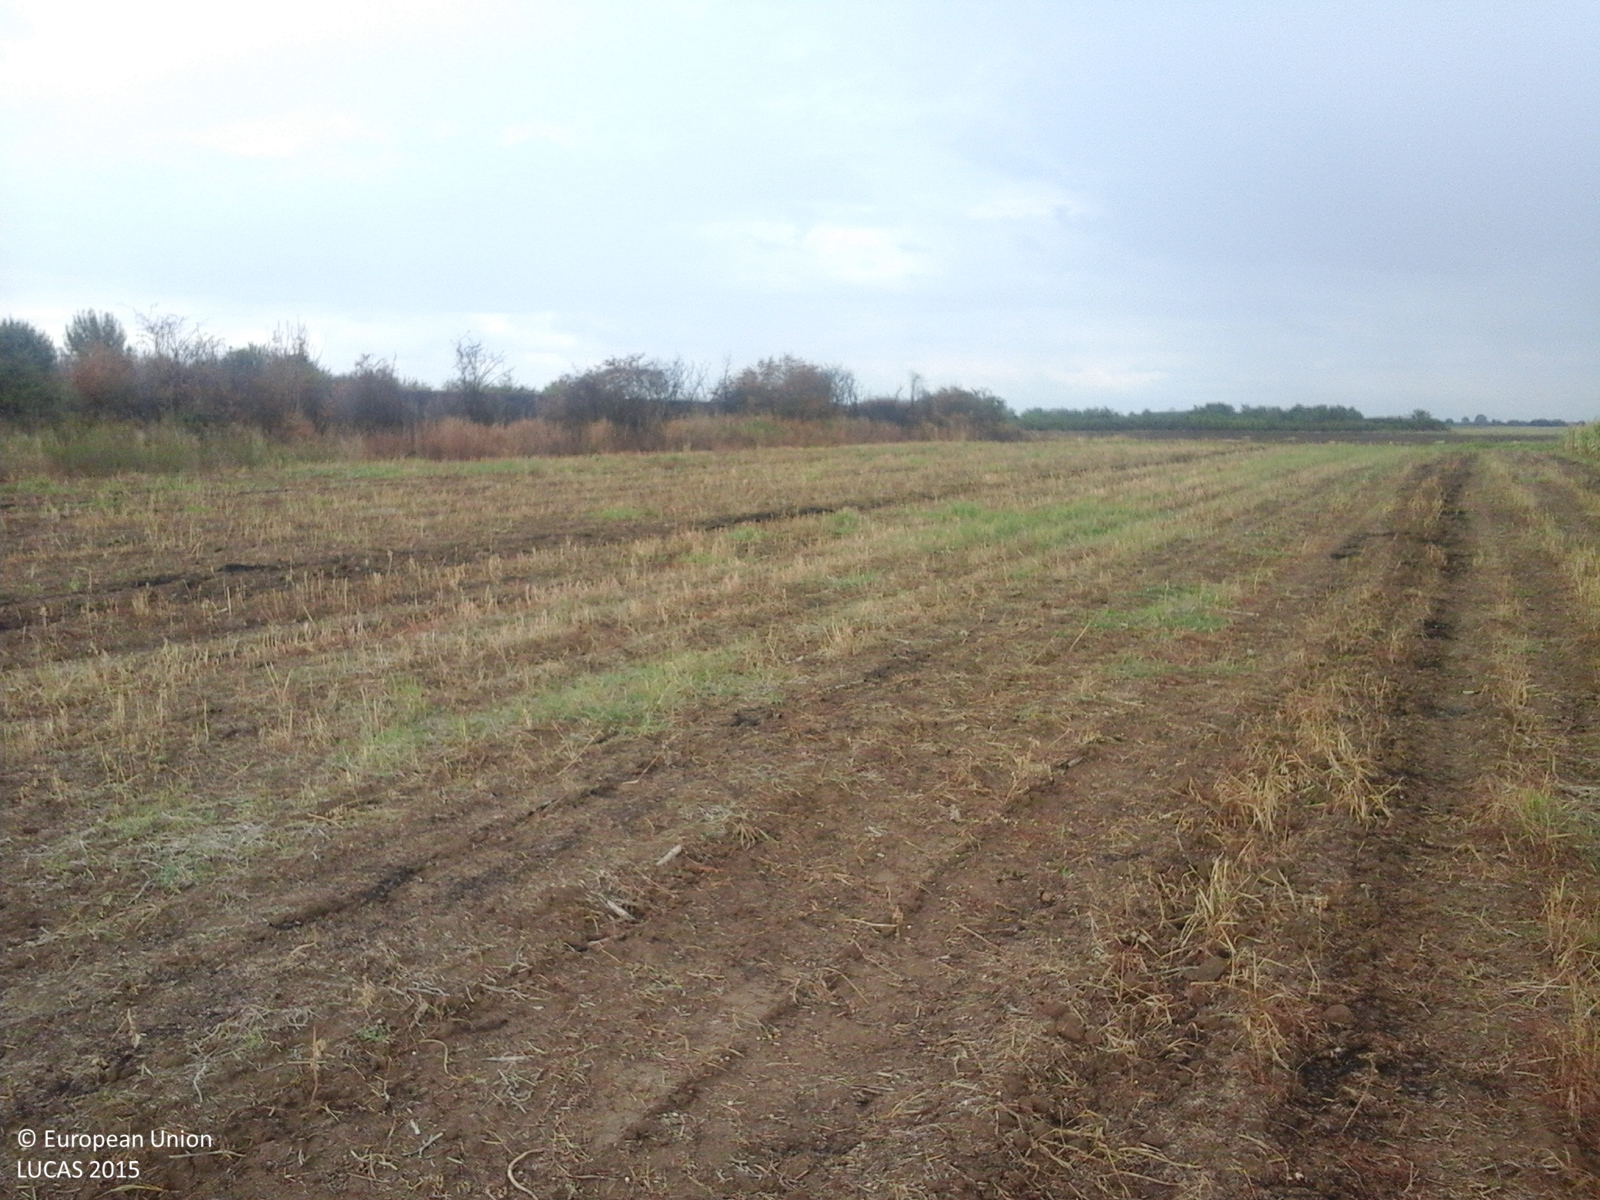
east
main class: Cropland
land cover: Other fresh vegetables
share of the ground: < 10 %
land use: Agriculture (excluding fallow land and kitchen gardens)
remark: Burnt area
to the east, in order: Other fresh vegetables; Tracks; Shrubland with sparse tree cover; Grass margins; Tracks; Common wheat
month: August
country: RO
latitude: 45.7222
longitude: 21.5592
